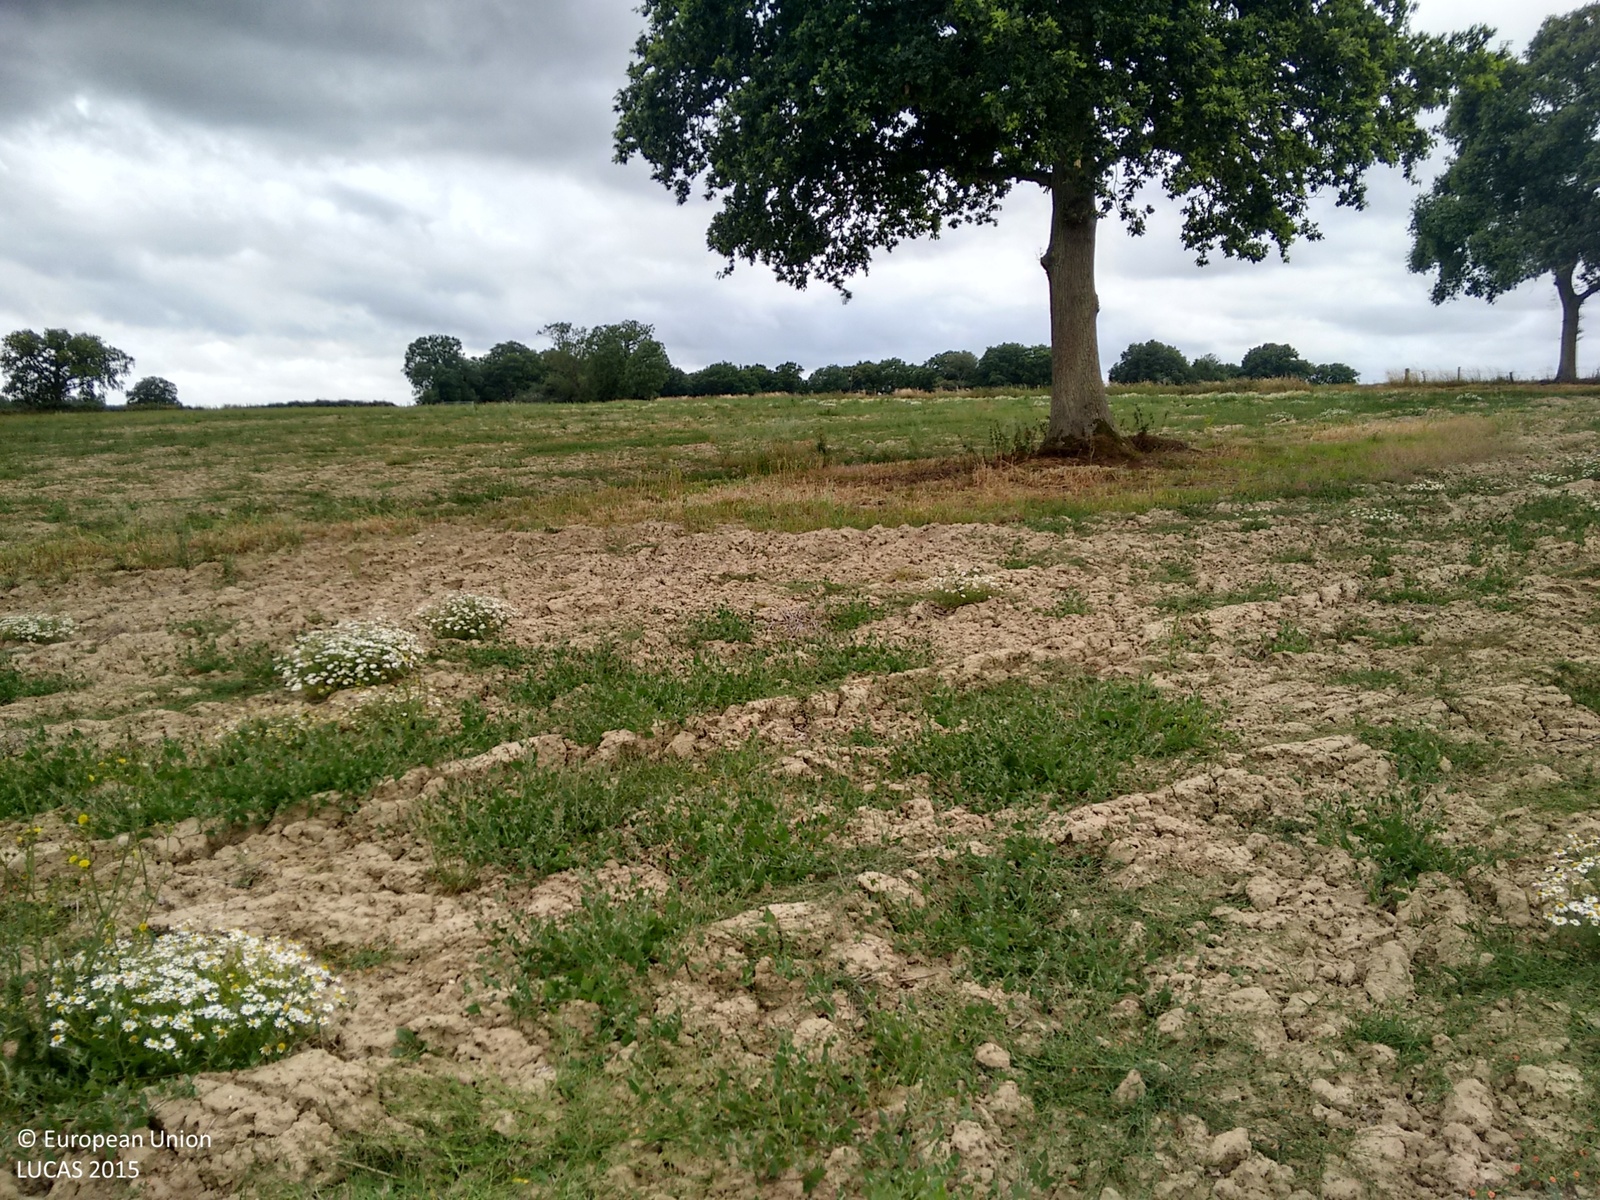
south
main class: Grassland
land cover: Spontaneously vegetated surfaces
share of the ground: 25 - 50 %
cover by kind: herbaceous plants 60 %, unconsolidated bare surface 40 %
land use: Fallow land
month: July
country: GB
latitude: 51.0940
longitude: -0.5046
